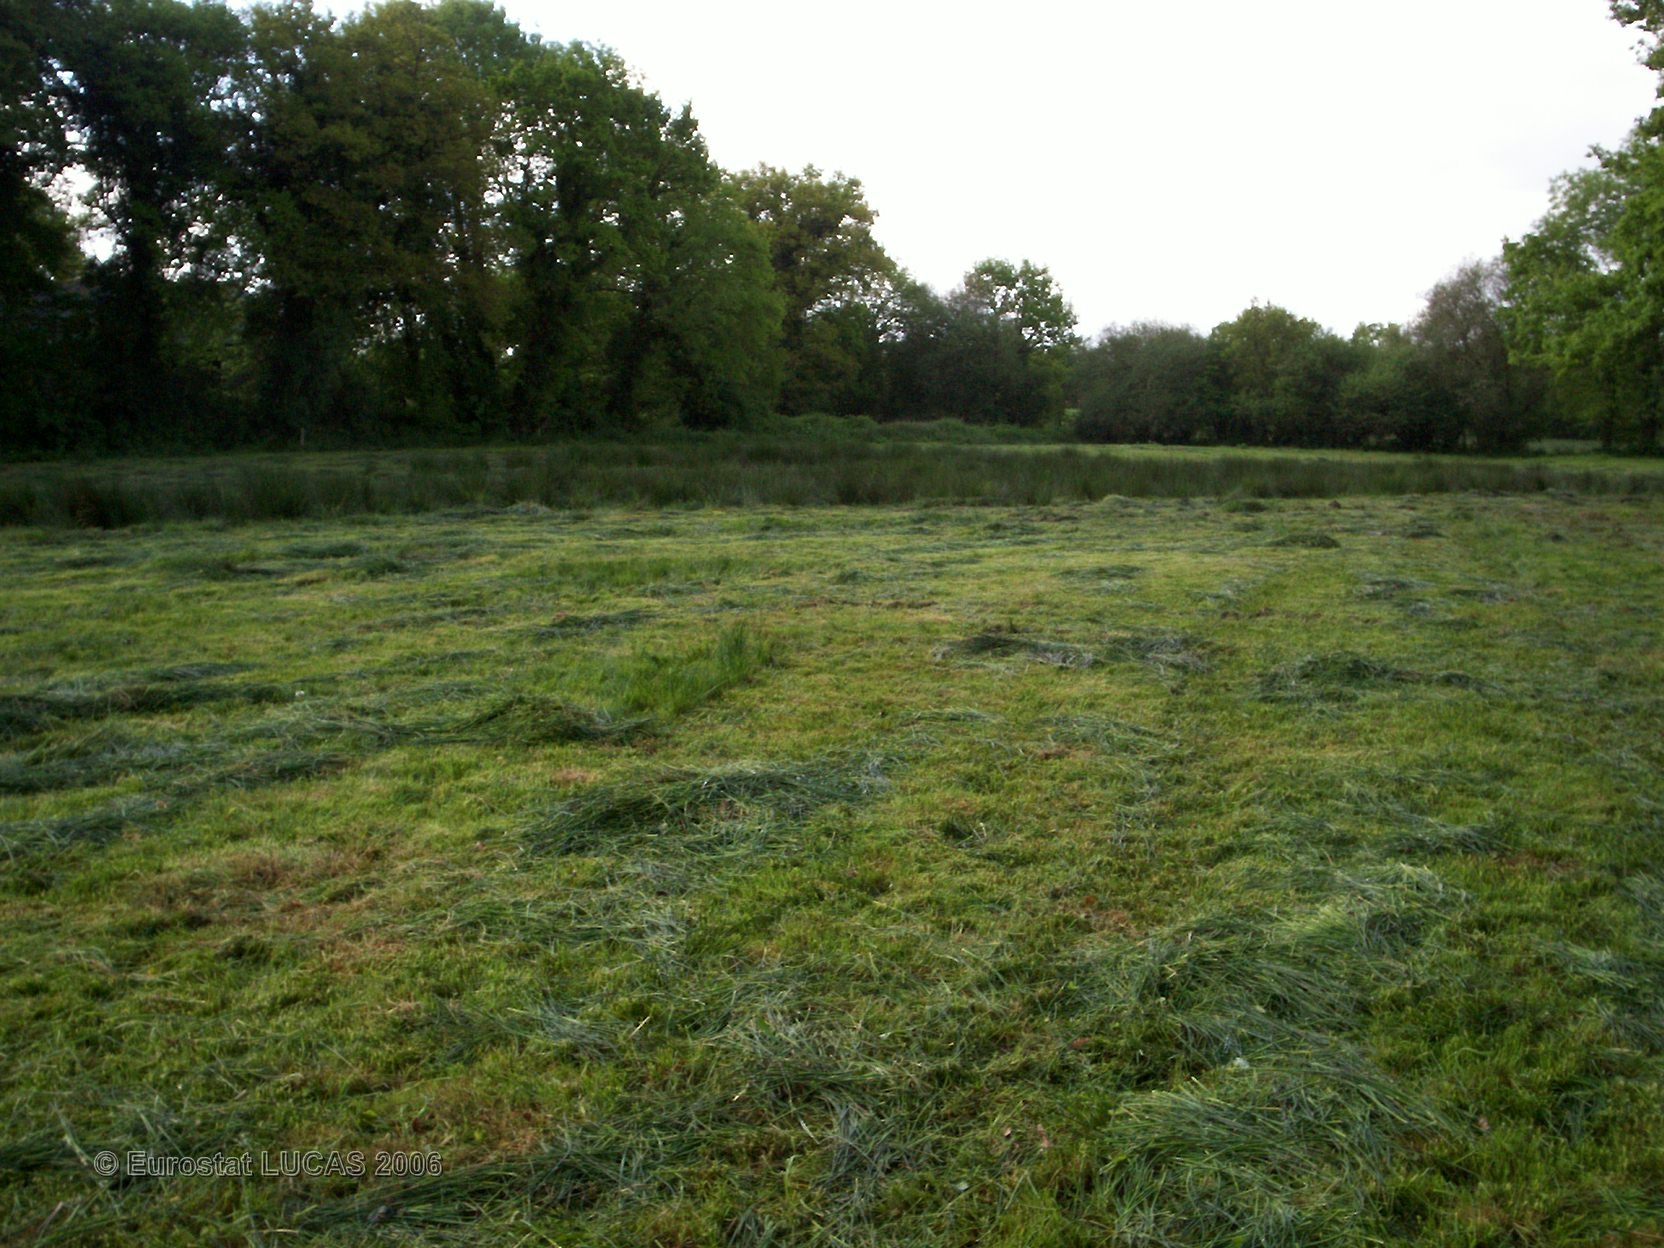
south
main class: Grassland
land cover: Grassland without tree/shrub cover
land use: Agriculture (excluding fallow land and kitchen gardens)
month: May
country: FR
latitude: 48.2888
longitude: -2.9942
